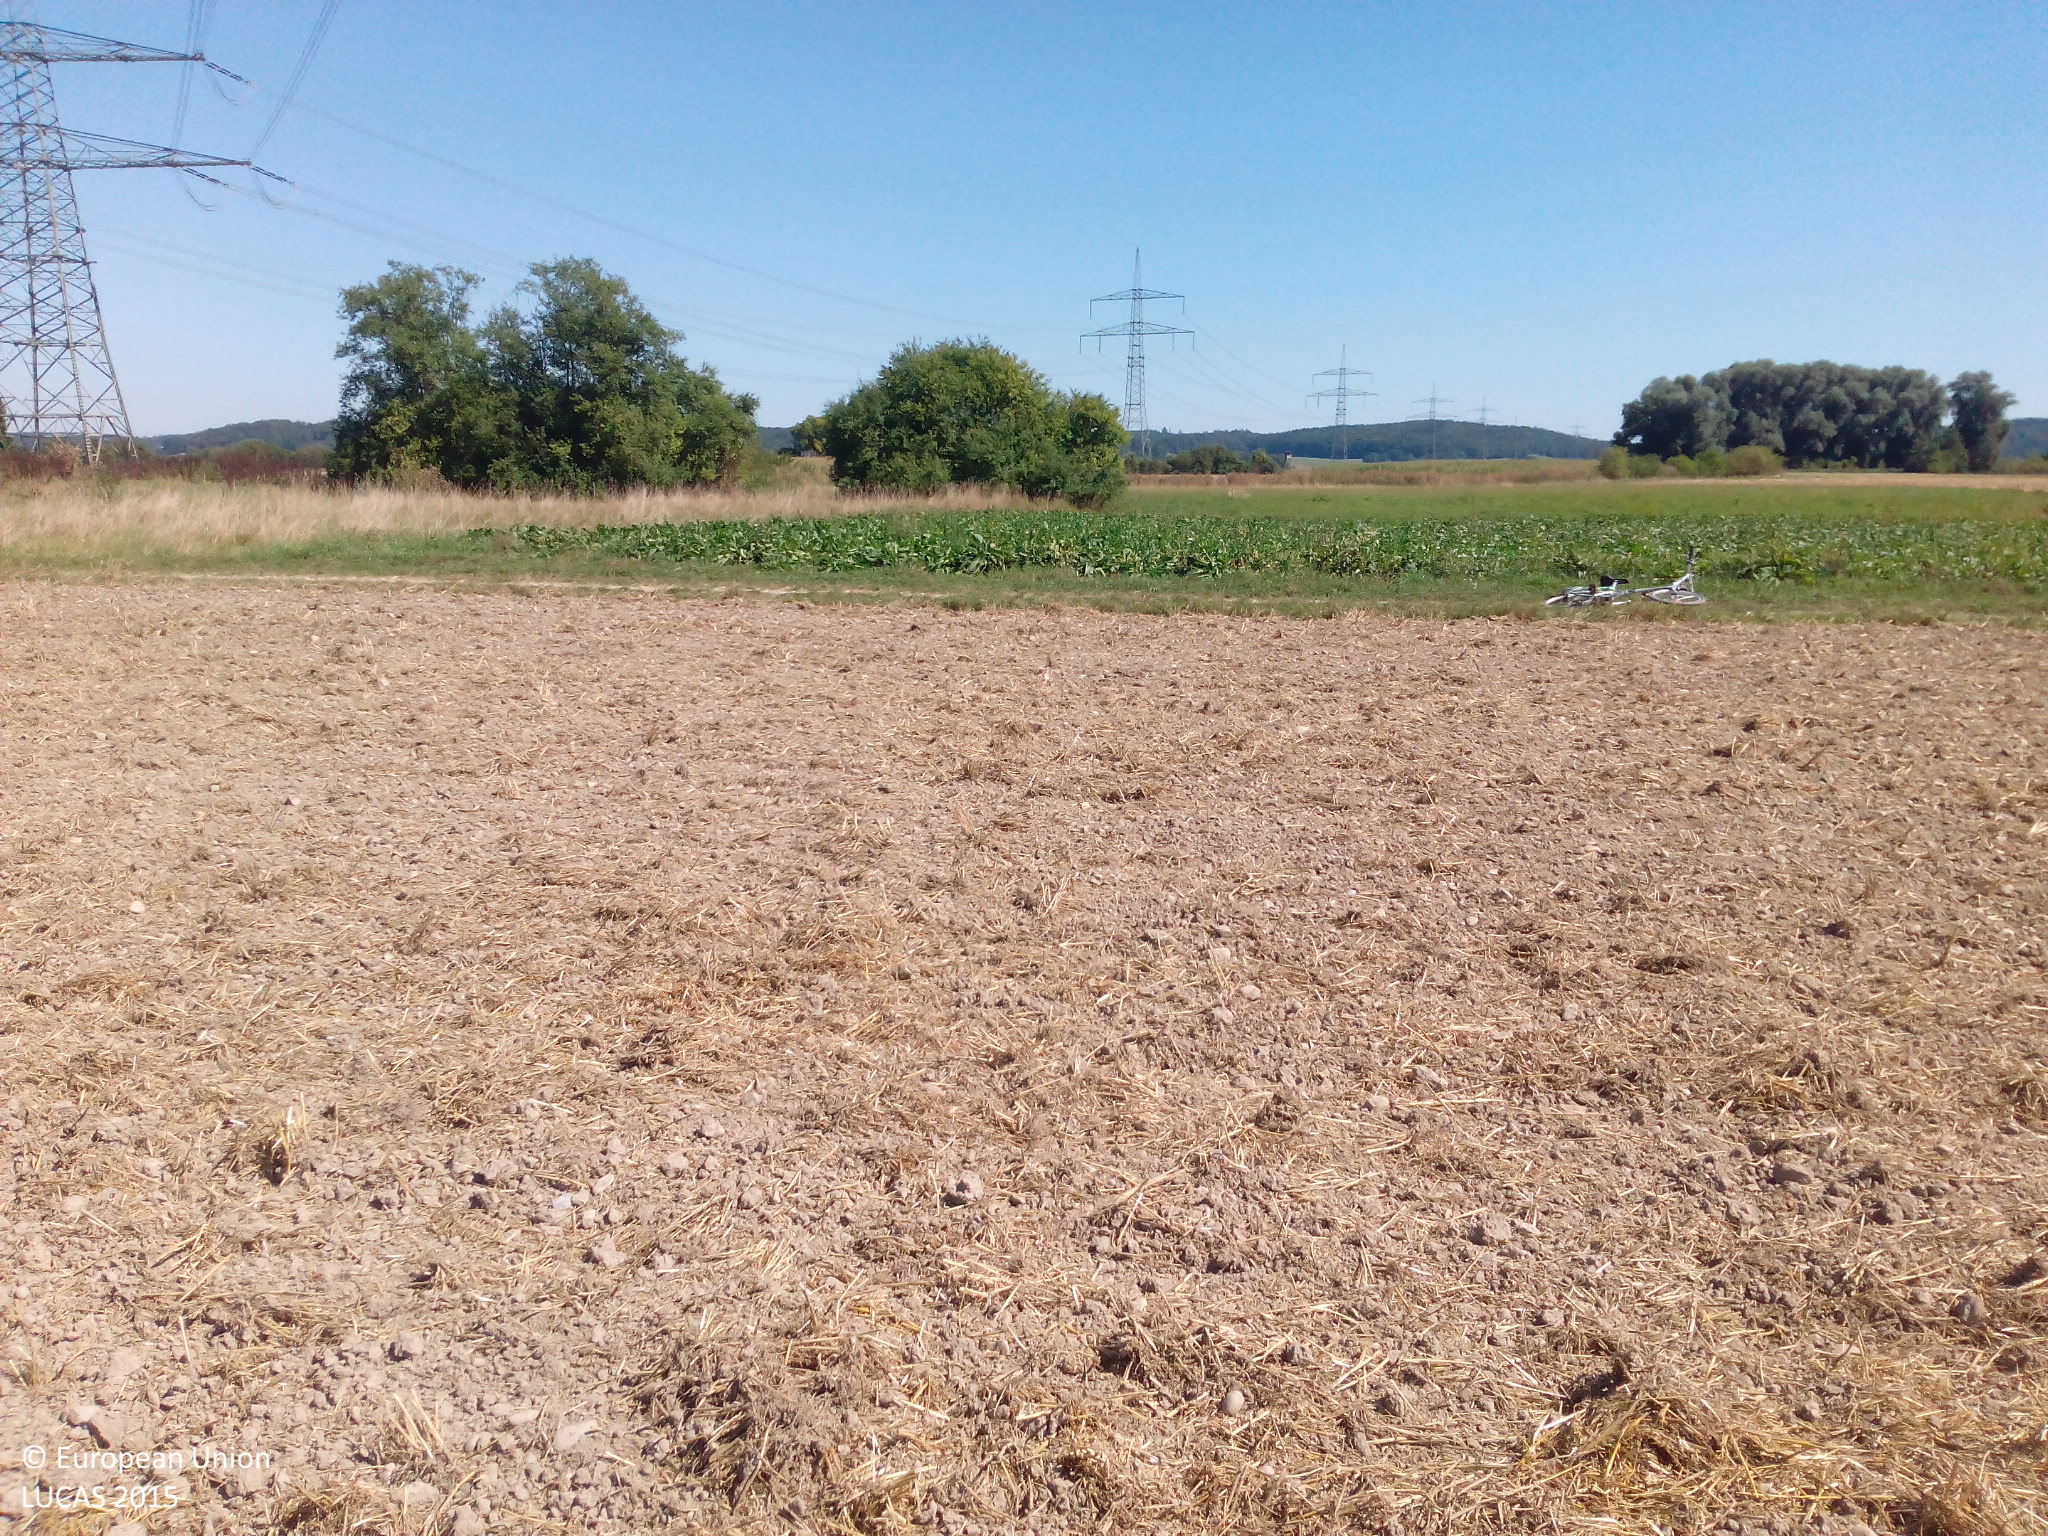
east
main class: Artificial land
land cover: Other artificial areas
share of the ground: < 10 %
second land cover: Common wheat
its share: < 10 %
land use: Electricity, gas and thermal power distribution
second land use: Agriculture (excluding fallow land and kitchen gardens)
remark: Harvested field
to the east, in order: Artificial constructions in urban areas; Common wheat; Tracks; Sugar beet; Grassland without tree/shrub cover; Tracks; Grassland without tree/shrub cover; Shruby margins; Ditches and canals; Shruby margins; Other bare soil
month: August
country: DE
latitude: 48.5439
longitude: 10.8800
